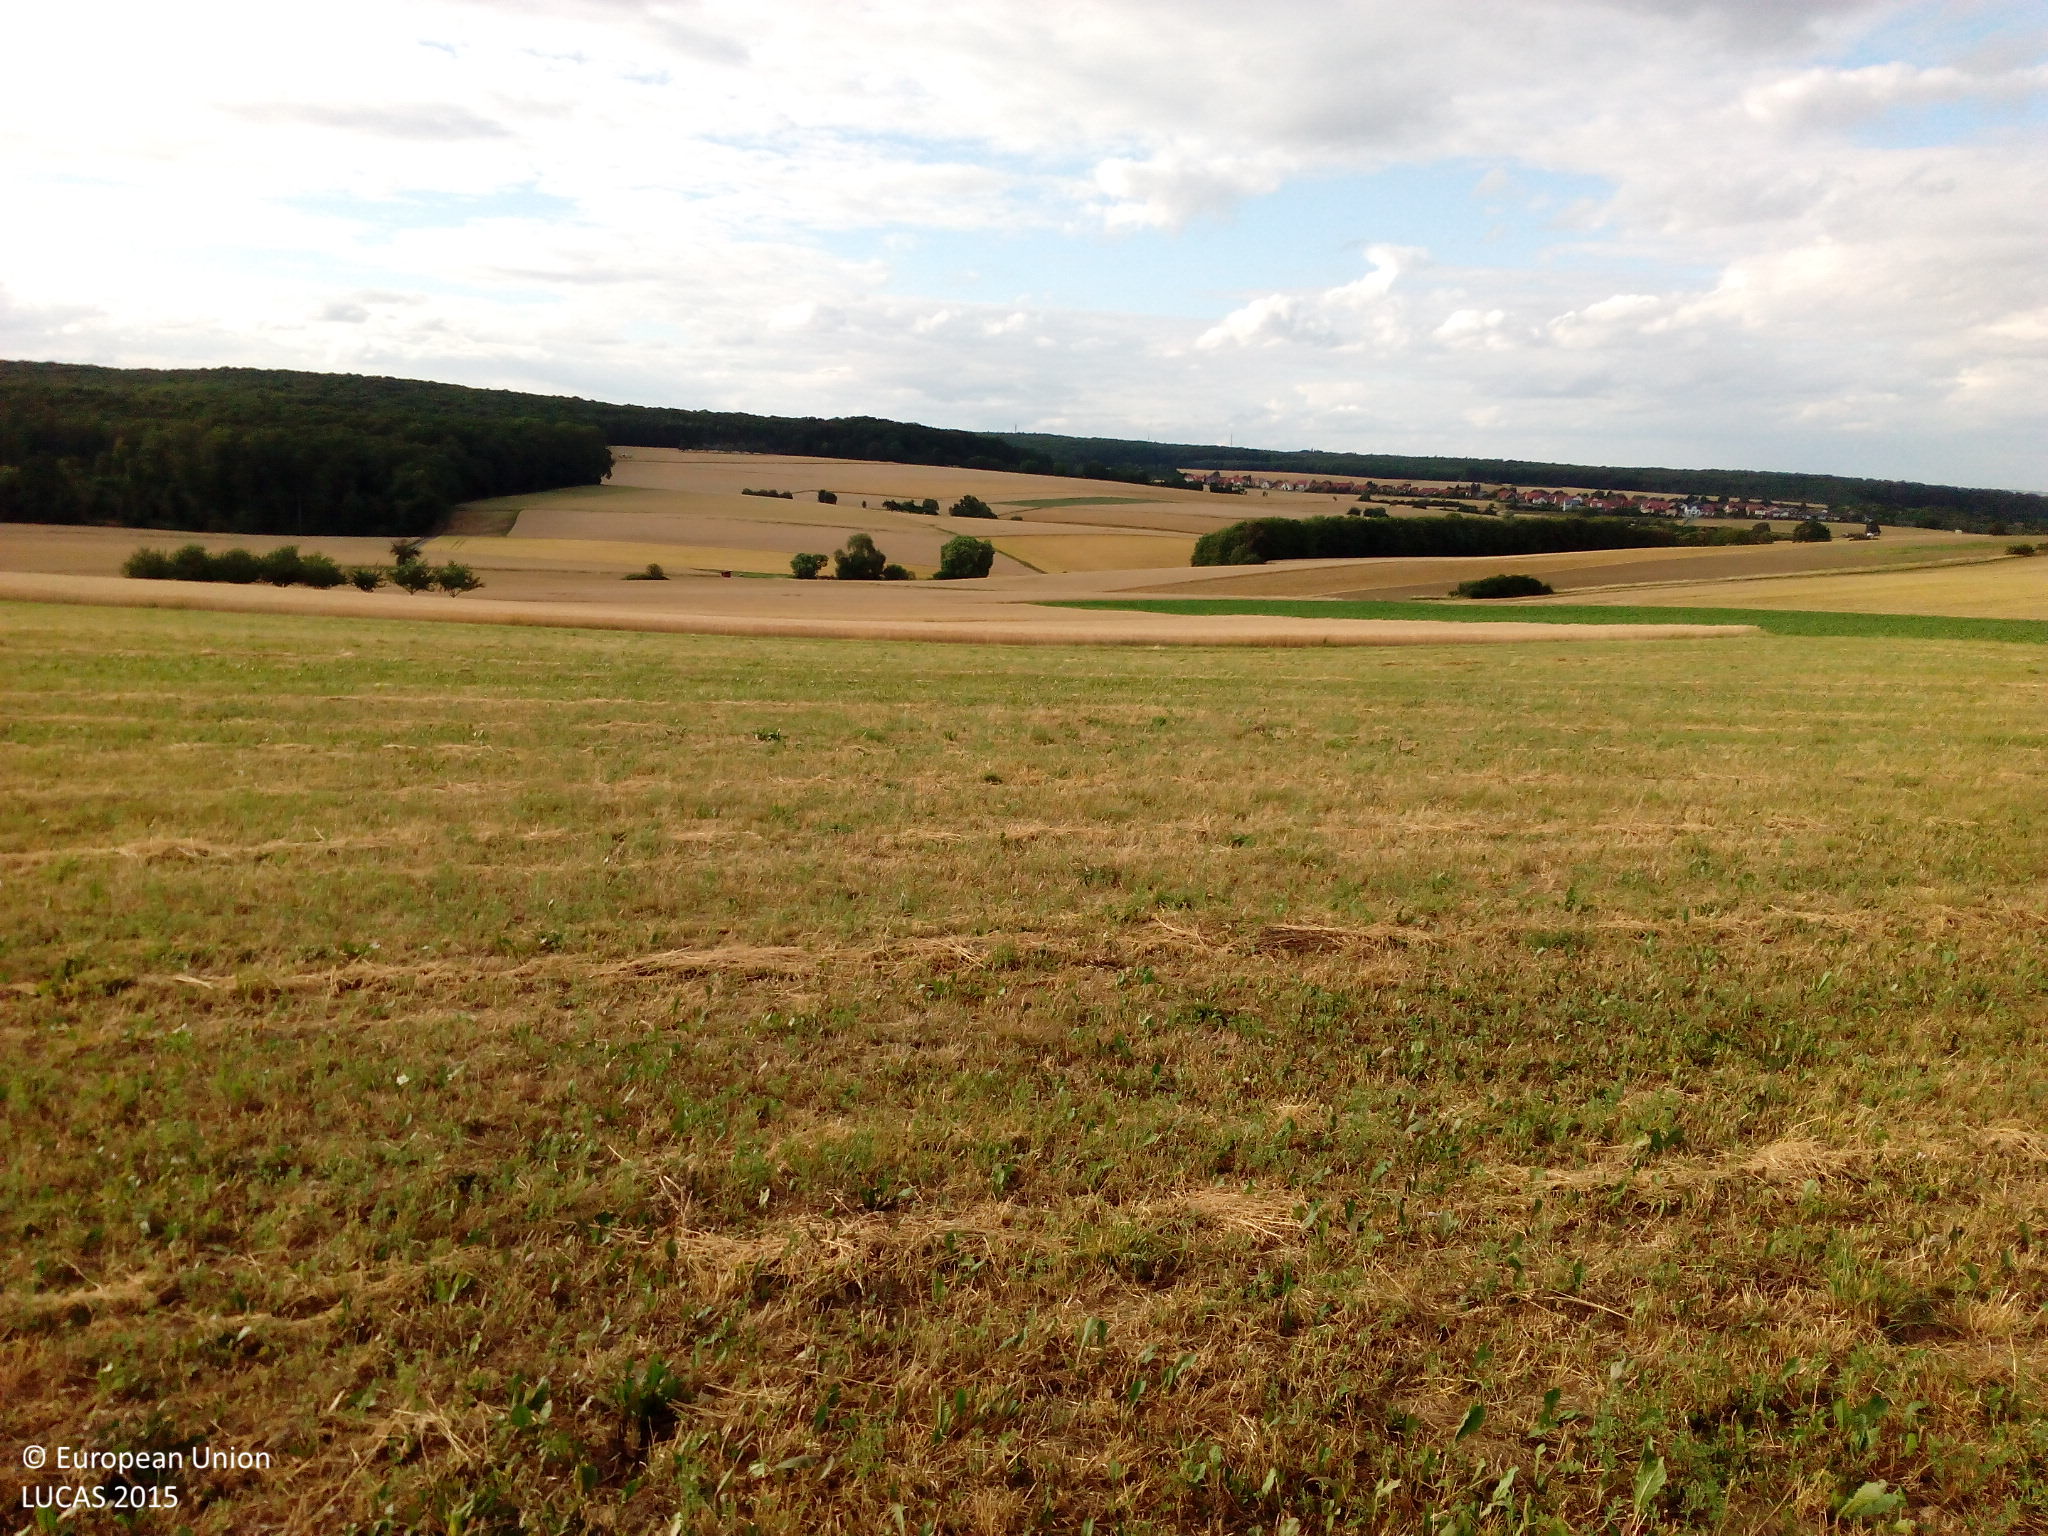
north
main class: Grassland
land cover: Grassland without tree/shrub cover
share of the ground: > 75 %
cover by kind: herbaceous plants 85 %, unconsolidated bare surface 15 %
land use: Agriculture (excluding fallow land and kitchen gardens)
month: July
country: DE
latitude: 49.7166
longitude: 9.9030
